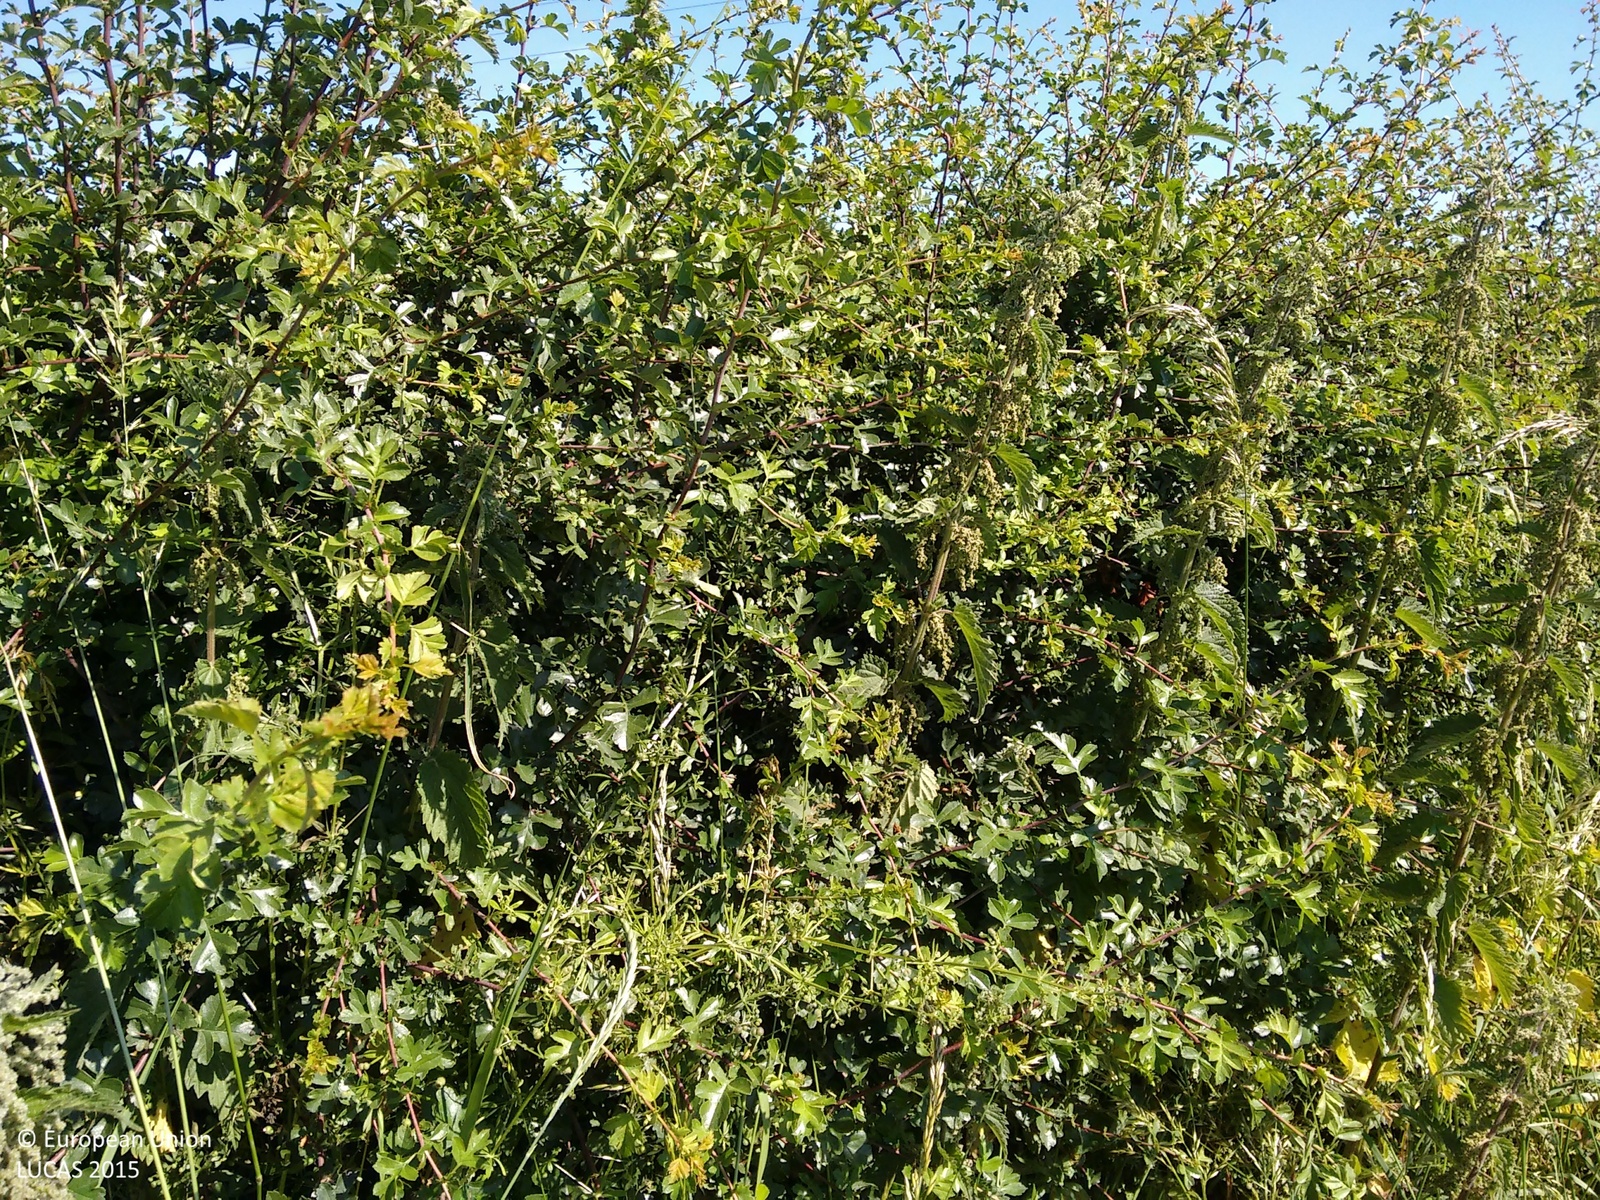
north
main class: Cropland
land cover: Common wheat
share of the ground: > 75 %
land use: Agriculture (excluding fallow land and kitchen gardens)
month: July
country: GB
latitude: 52.8975
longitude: -0.8191
